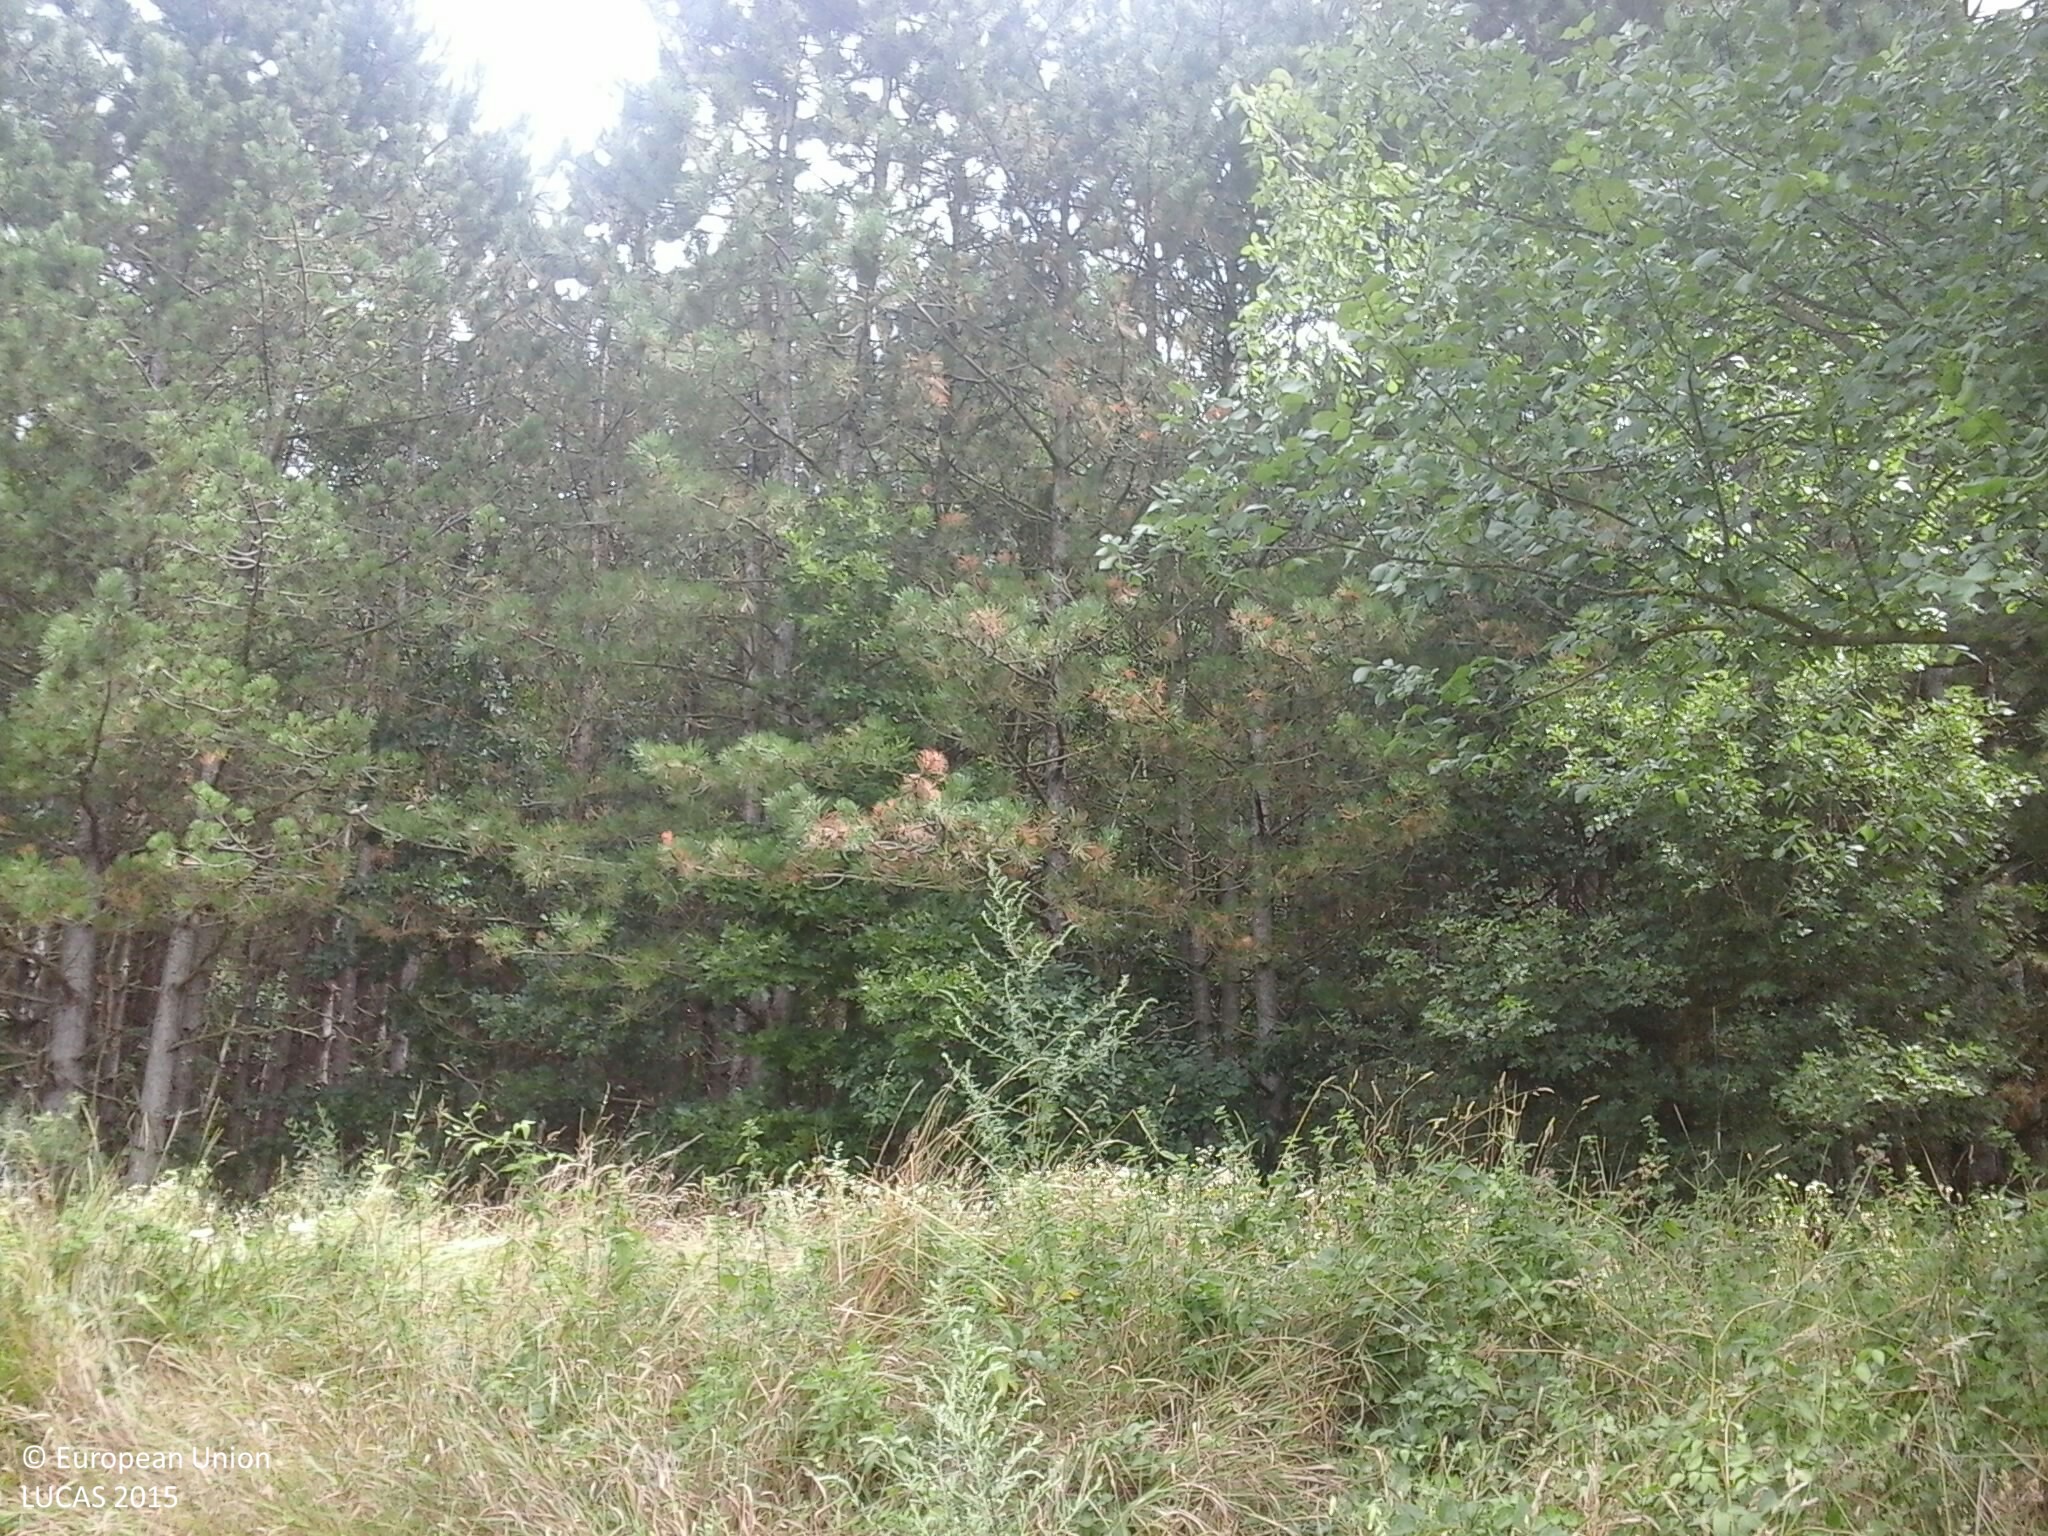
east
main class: Cropland
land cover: Maize
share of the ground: > 75 %
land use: Agriculture (excluding fallow land and kitchen gardens)
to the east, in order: Maize; Grassland with sparse tree/shrub cover; Pine dominated mixed woodland; Broadleaved woodland
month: July
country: HU
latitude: 46.6727
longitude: 17.9159
